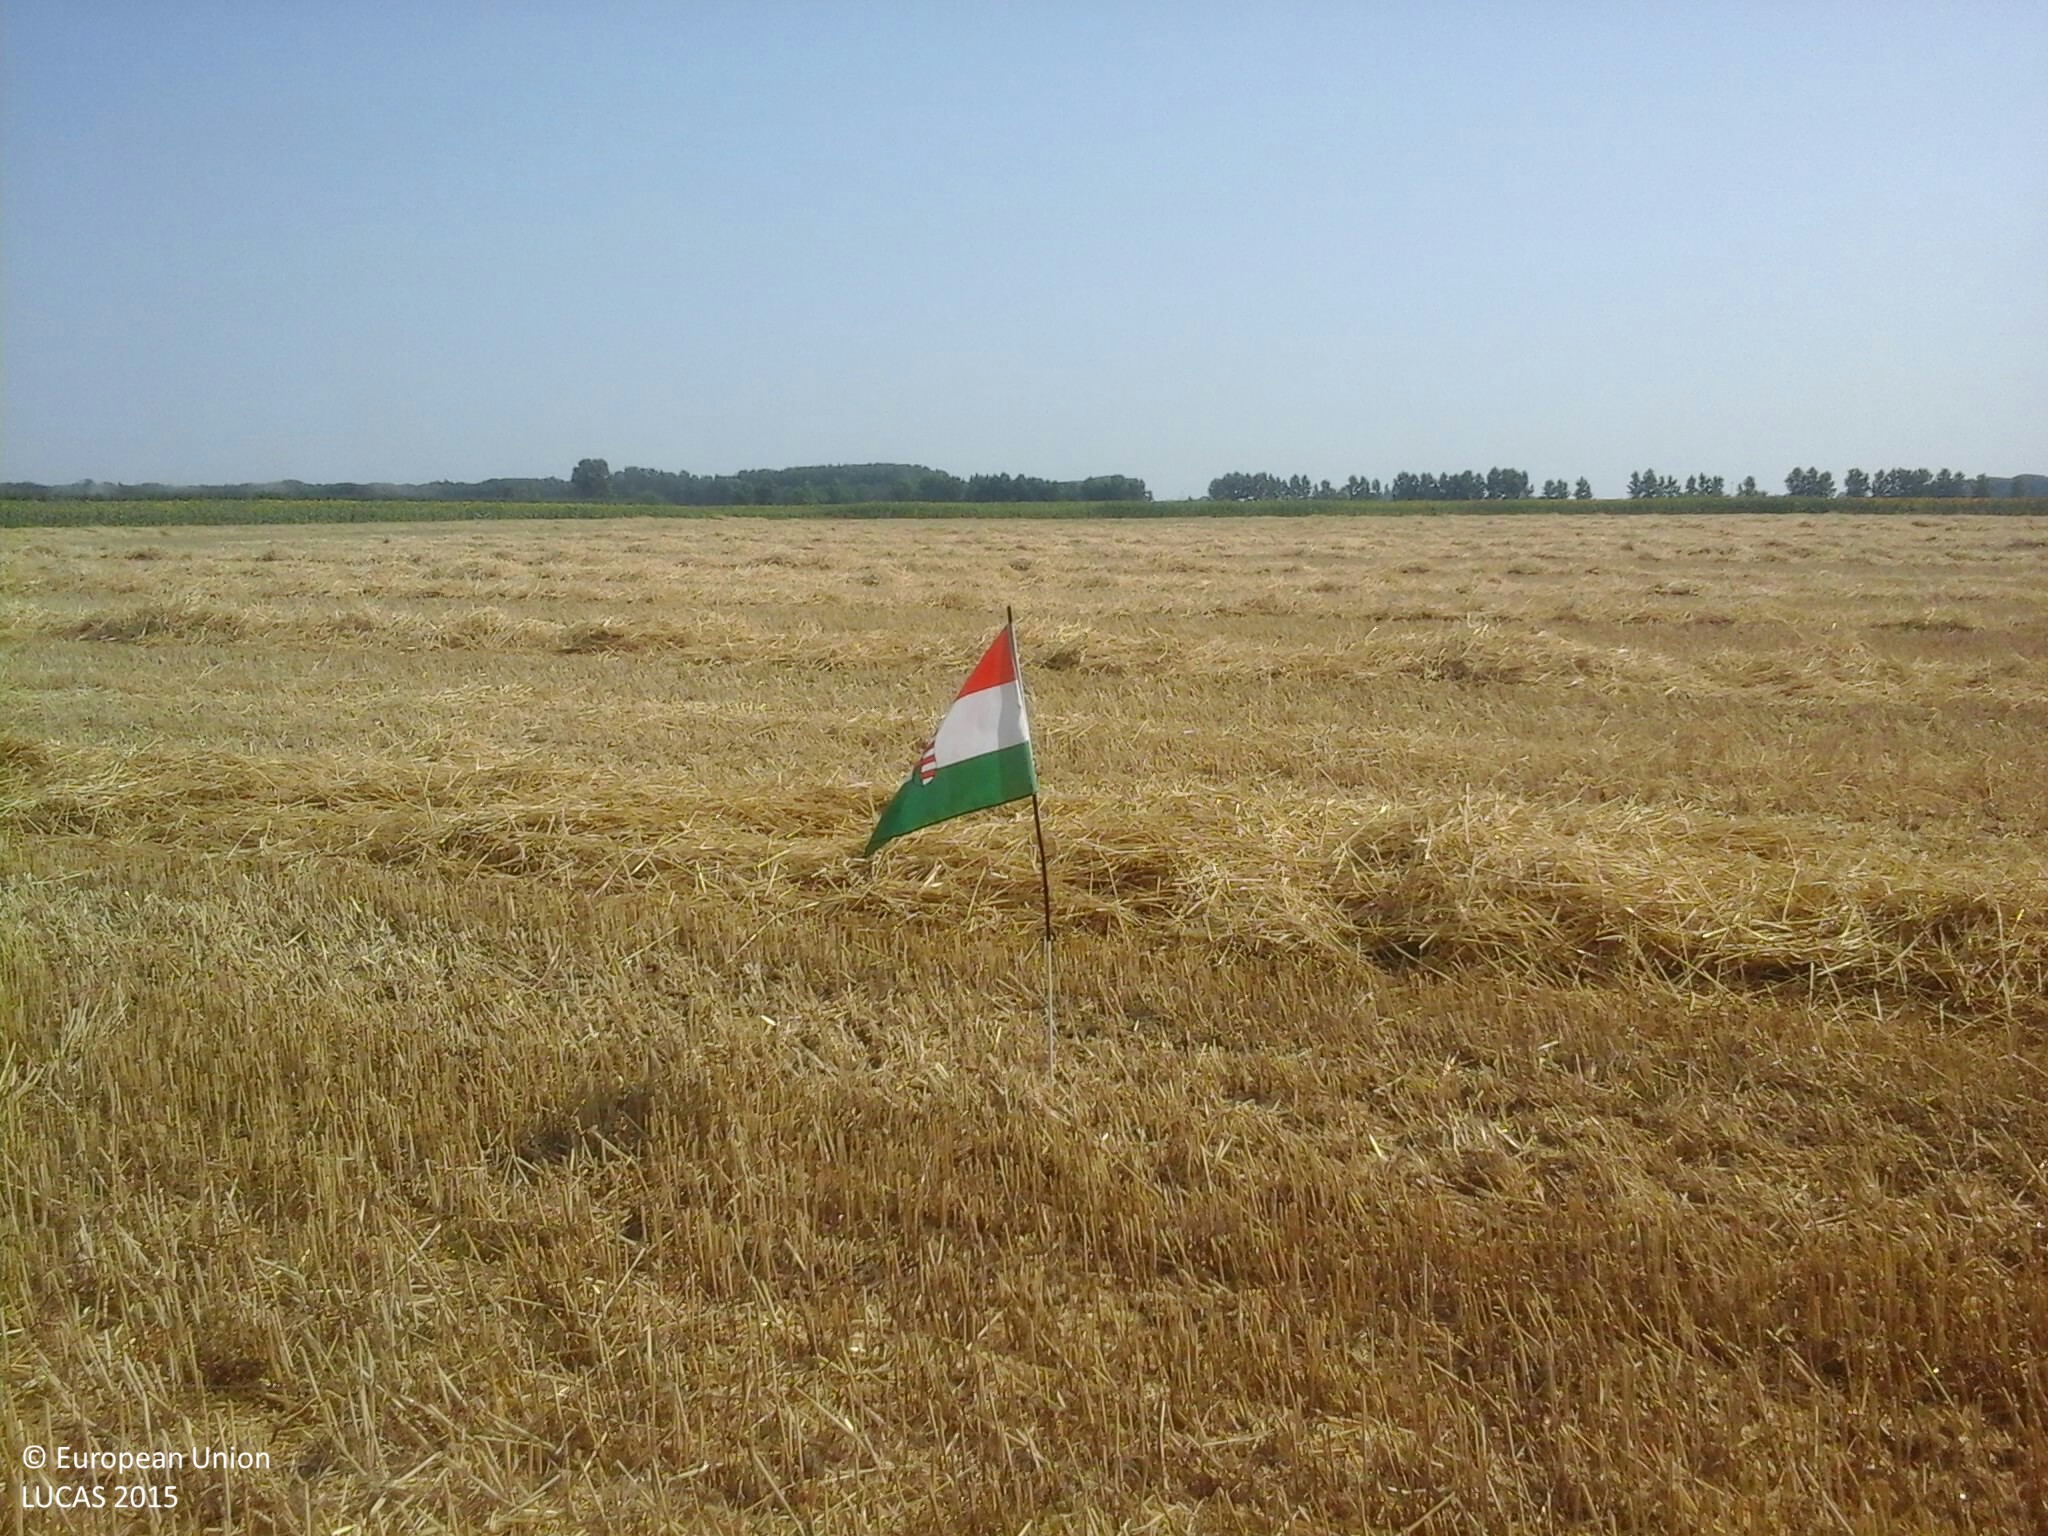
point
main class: Cropland
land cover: Common wheat
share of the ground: > 75 %
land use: Agriculture (excluding fallow land and kitchen gardens)
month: July
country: HU
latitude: 47.2225
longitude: 18.9831
